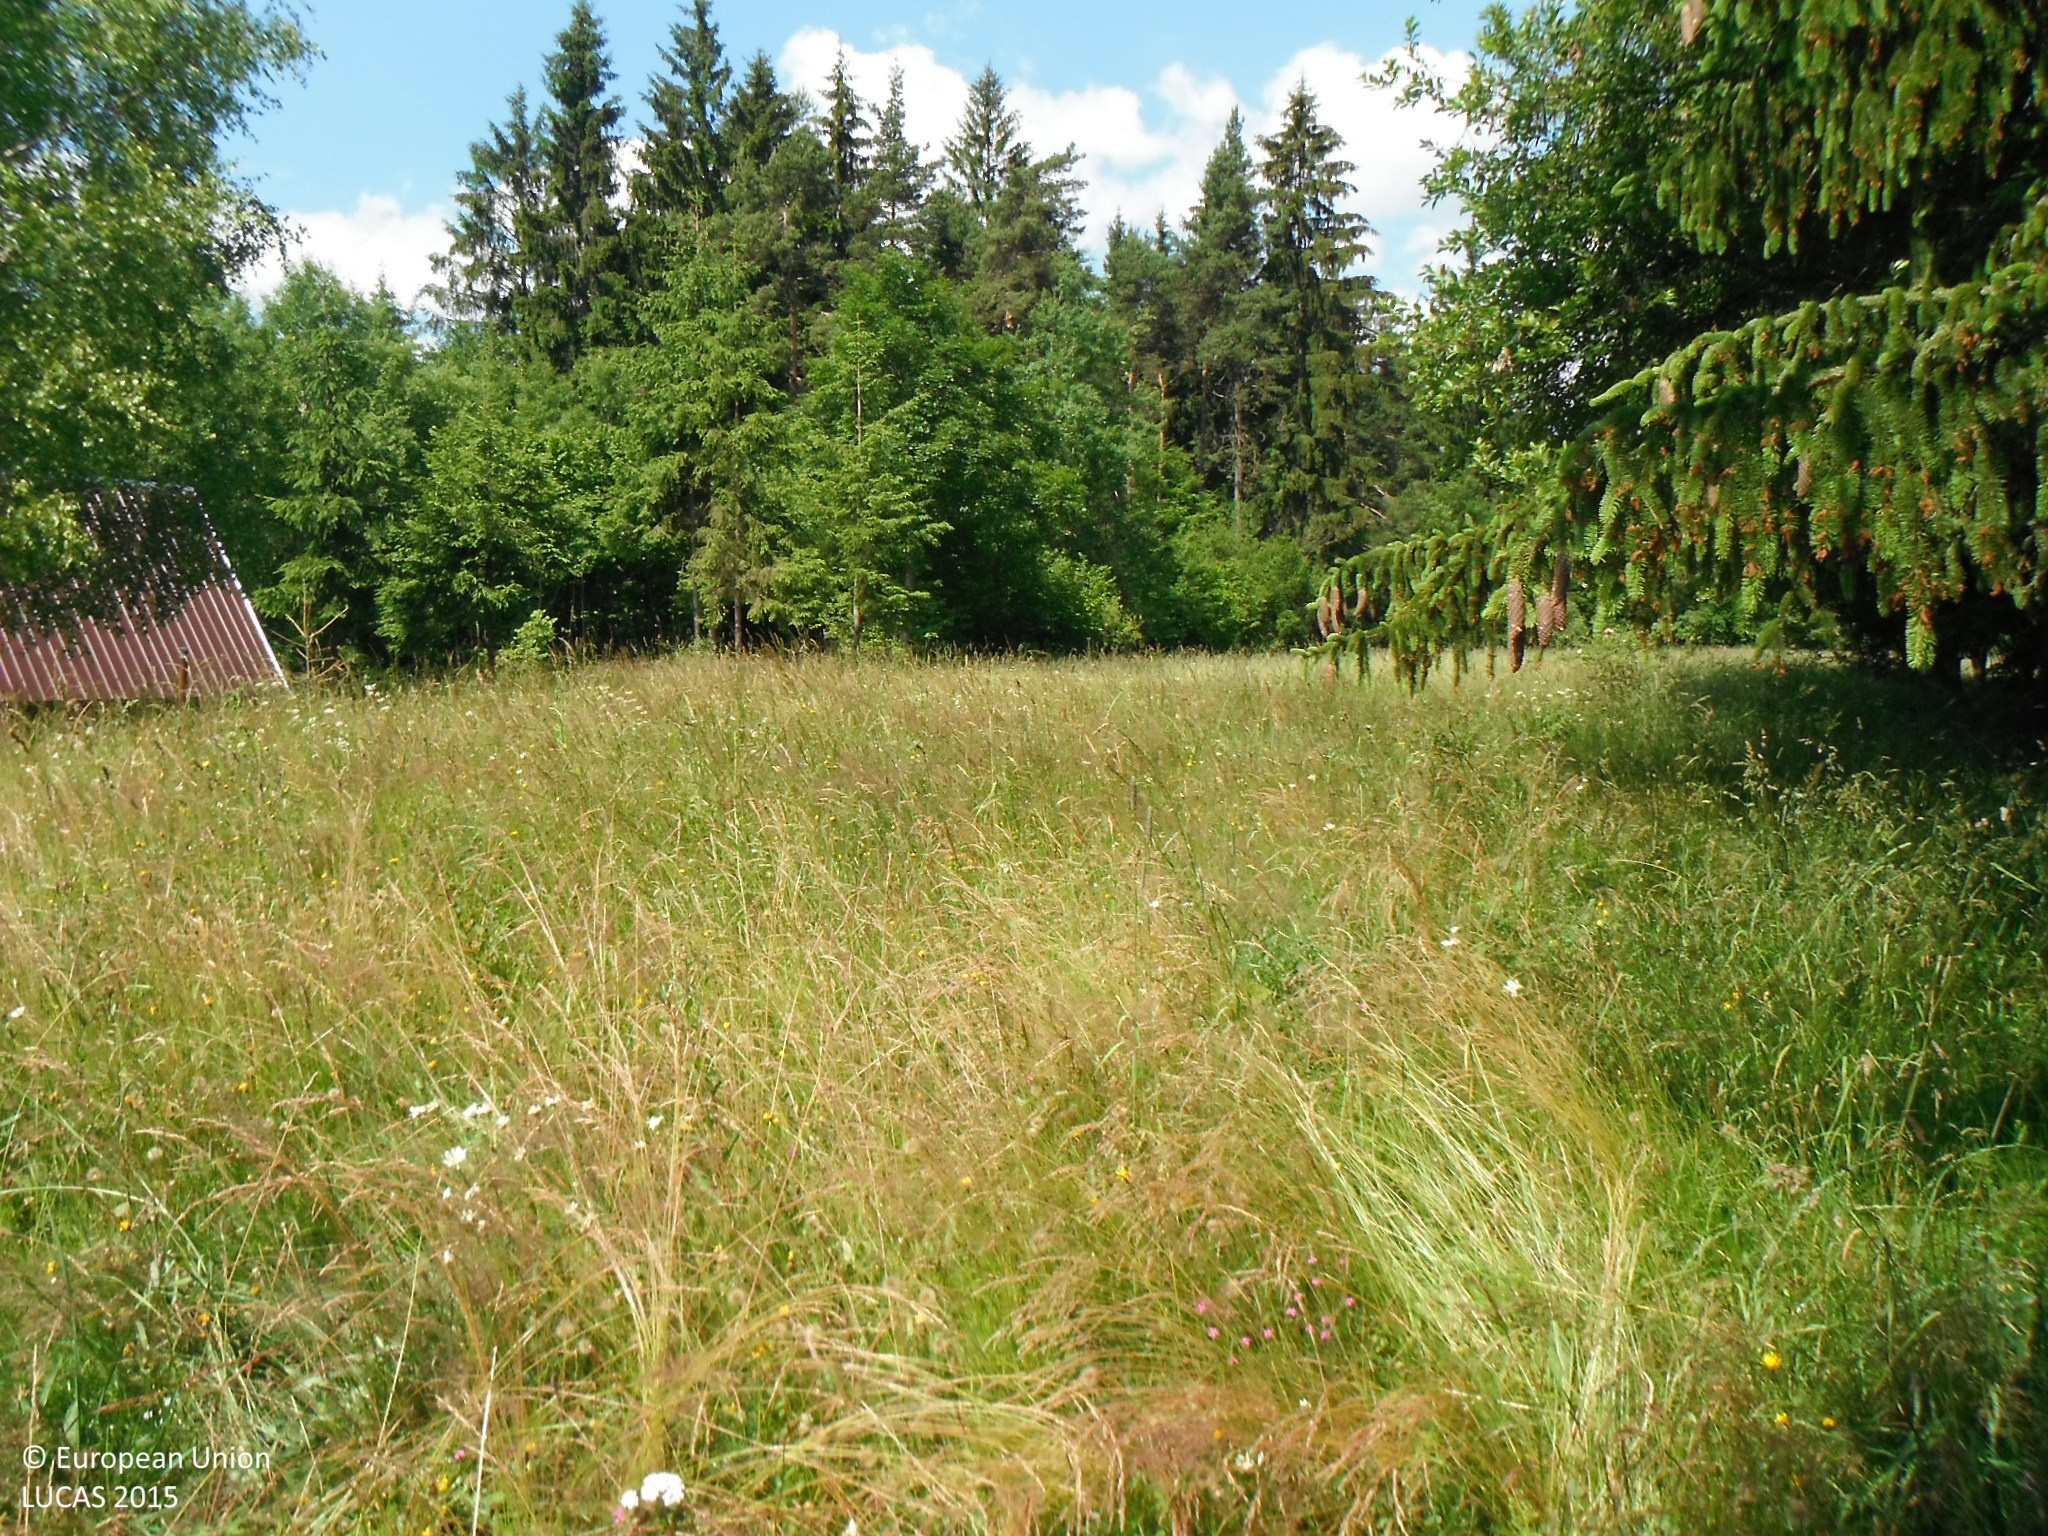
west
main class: Grassland
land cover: Grassland without tree/shrub cover
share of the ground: > 75 %
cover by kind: herbaceous plants 95 %, shrubs 5 %
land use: Agriculture (excluding fallow land and kitchen gardens)
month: July
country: SK
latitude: 49.3412
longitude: 18.5103
